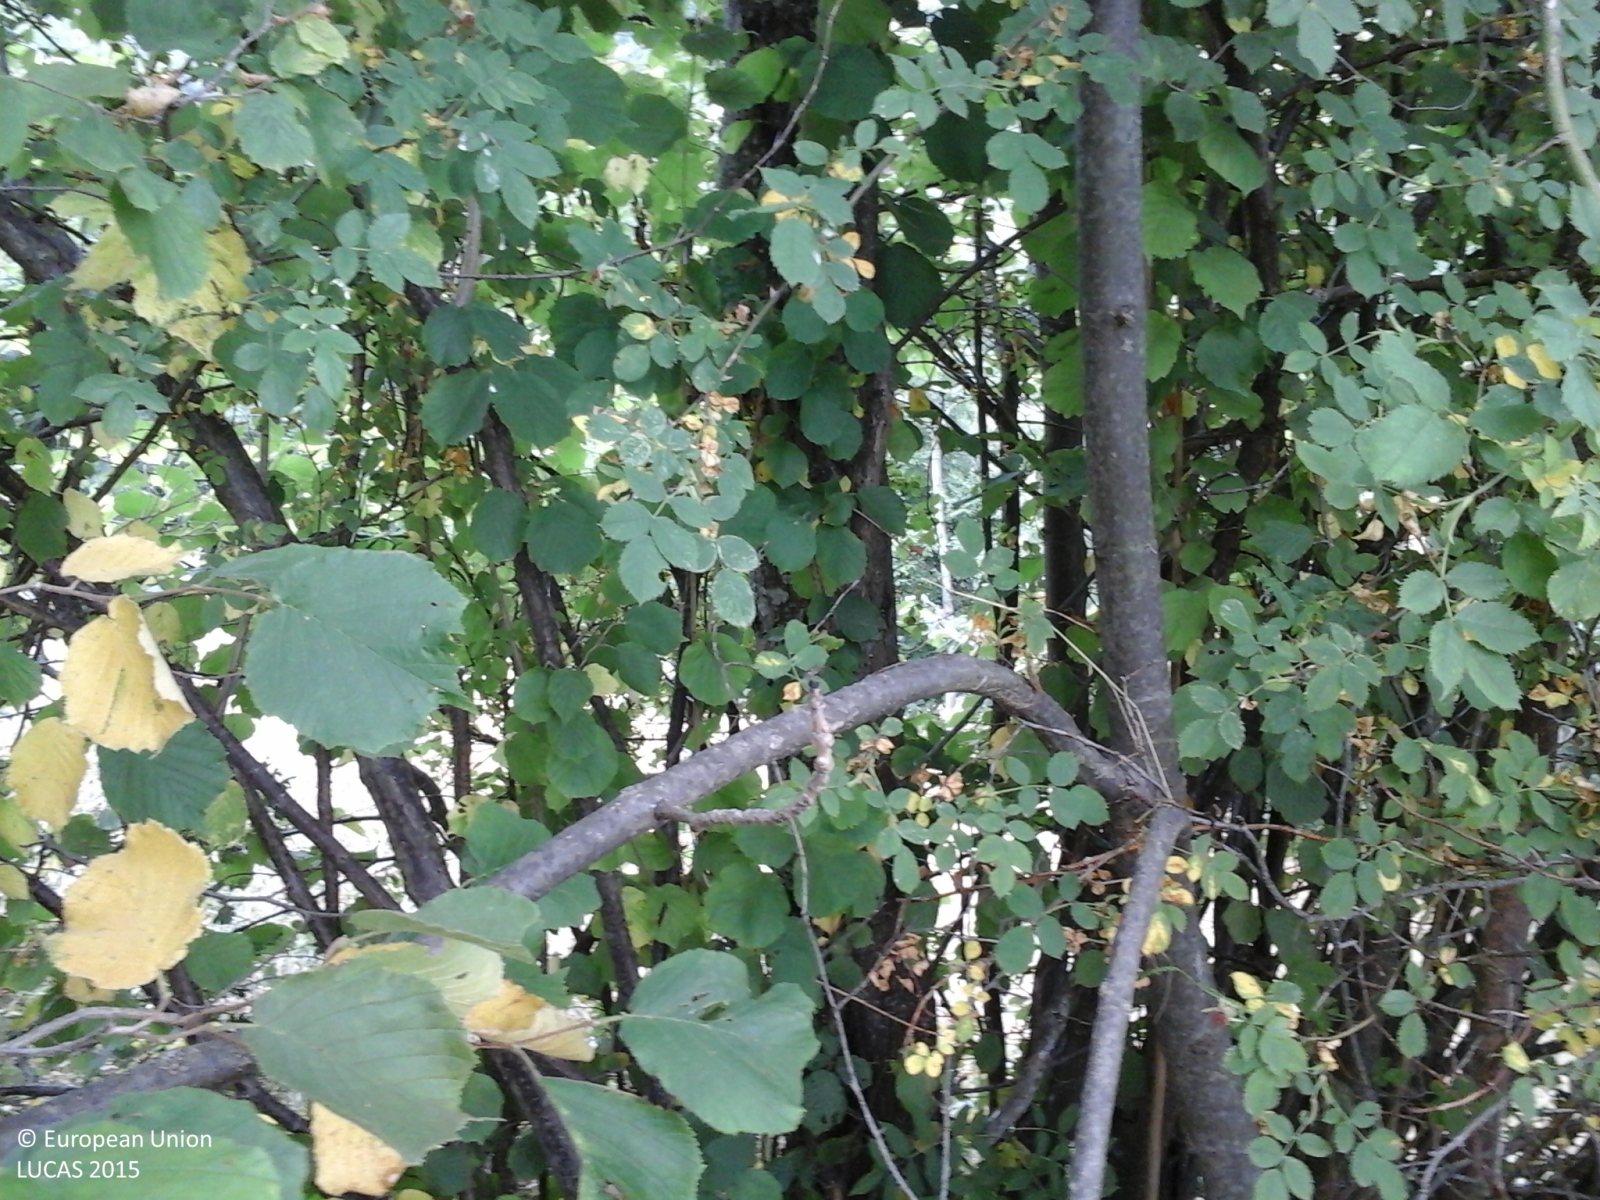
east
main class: Woodland
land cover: Broadleaved woodland
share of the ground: > 75 %
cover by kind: broadleaved forest trees 100 %
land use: Forestry
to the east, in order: Dry stone walls; Grassland without tree/shrub cover; Broadleaved woodland; Fences; Grassland without tree/shrub cover; Fences; Dry stone walls; Managed hedges; Tracks; Managed hedges; Grassland without tree/shrub cover; Managed hedges; Tracks; Fences; Grassland without tree/shrub cover; Fences; Lines of trees; Paved roads, cycling and walking lanes; Dry stone walls; Managed hedges; Fences; Grassland without tree/shrub cover; Broadleaved woodland; Grassland without tree/shrub cover; Broadleaved woodland
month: July
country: IT
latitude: 45.6247
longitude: 11.1141
